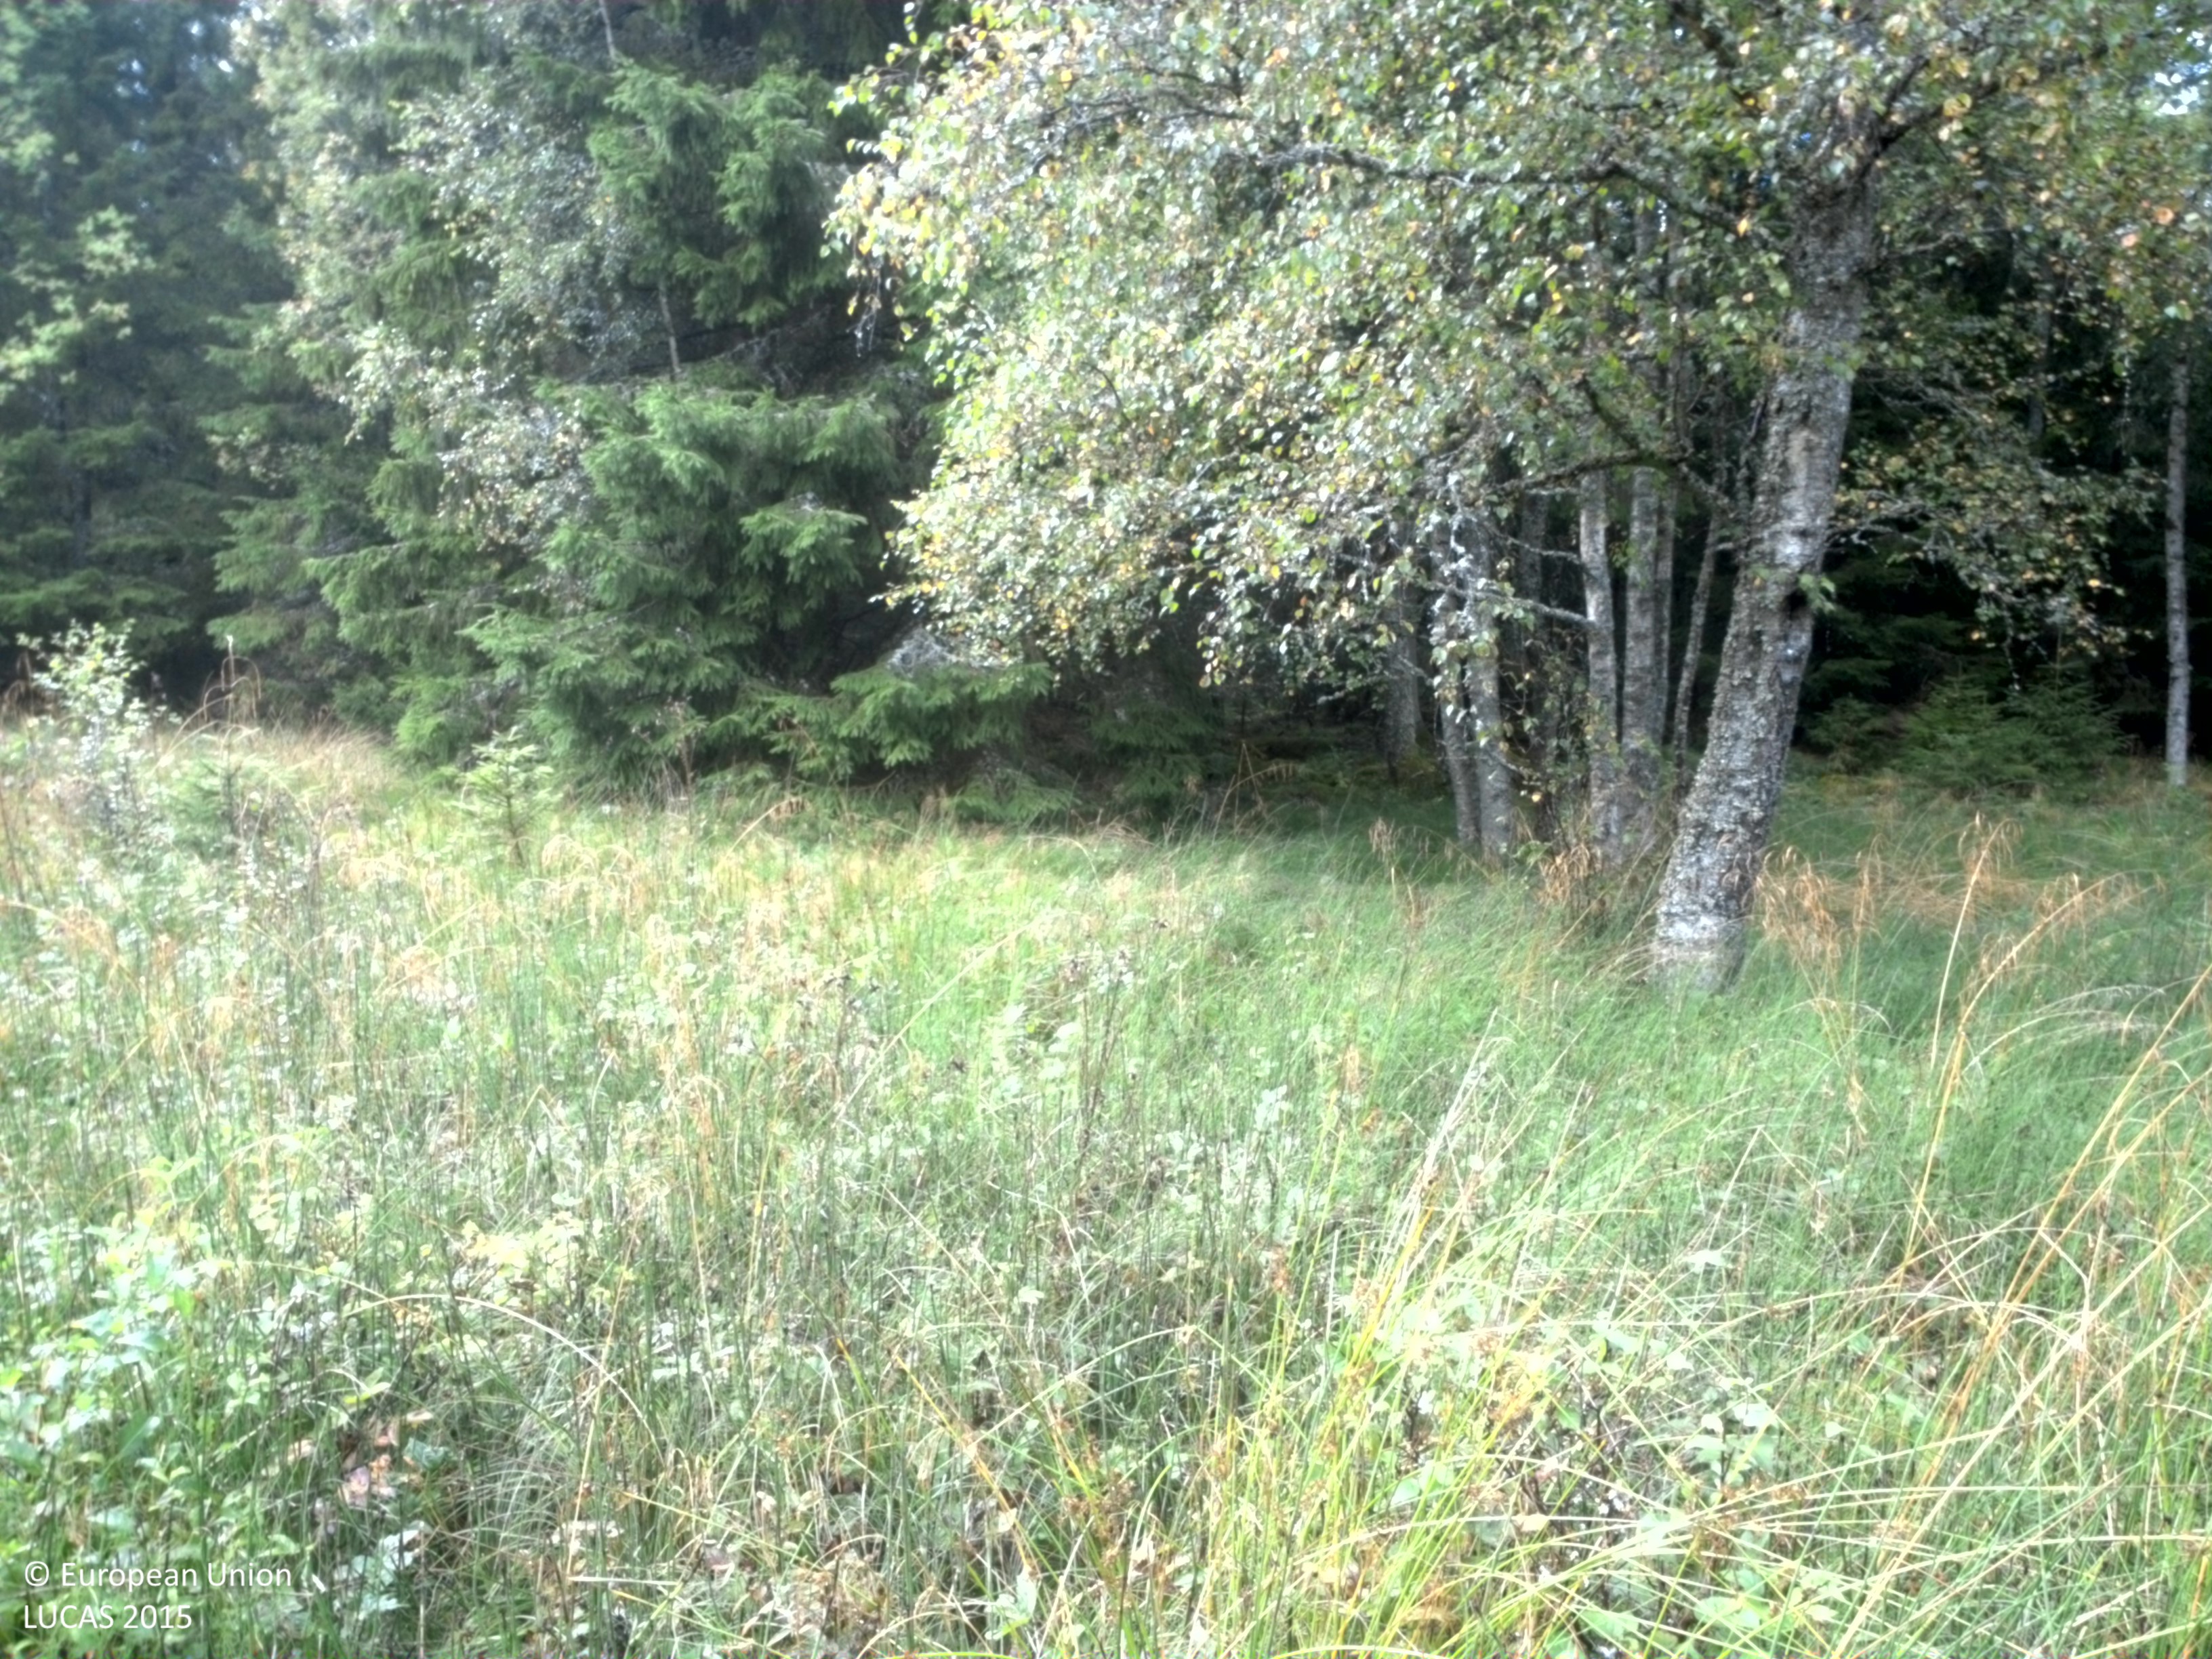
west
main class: Grassland
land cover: Grassland without tree/shrub cover
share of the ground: > 75 %
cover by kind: herbaceous plants 95 %, shrubs 5 %
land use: Semi-natural and natural areas not in use
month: August
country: SE
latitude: 57.8212
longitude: 13.2108
